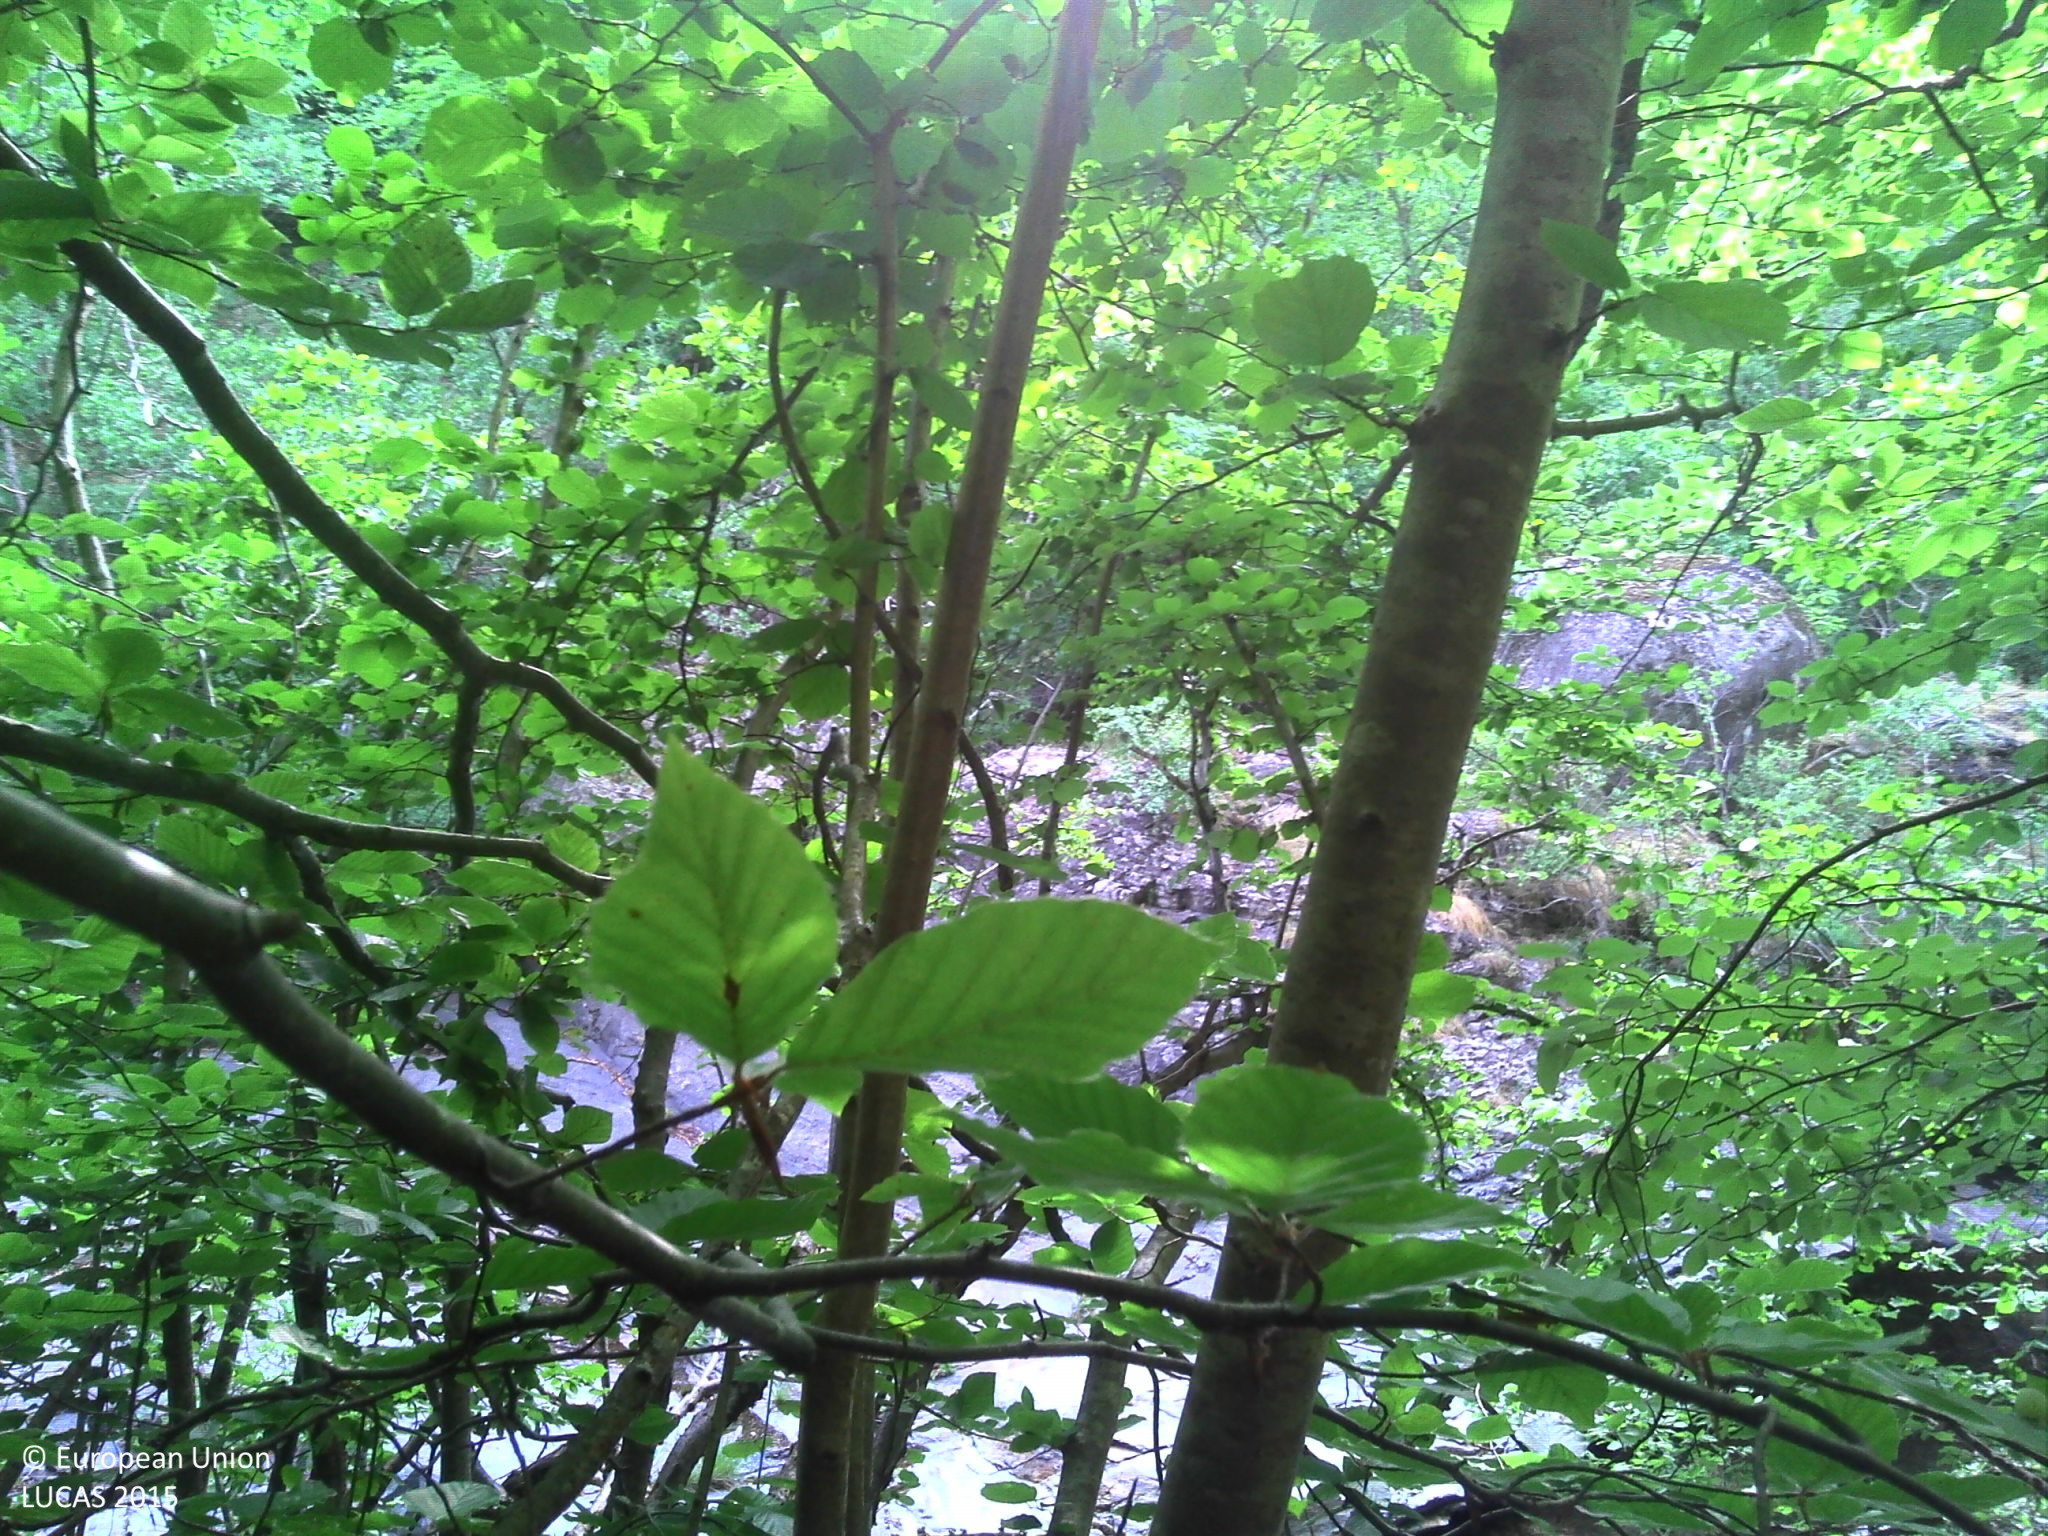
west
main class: Woodland
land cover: Broadleaved woodland
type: beech forest
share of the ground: > 75 %
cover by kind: broadleaved forest trees 85 %, herbaceous plants 10 %, coniferous forest trees 5 %
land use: Forestry
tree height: > 5 m
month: June
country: FR
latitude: 44.4251
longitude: 3.9142
